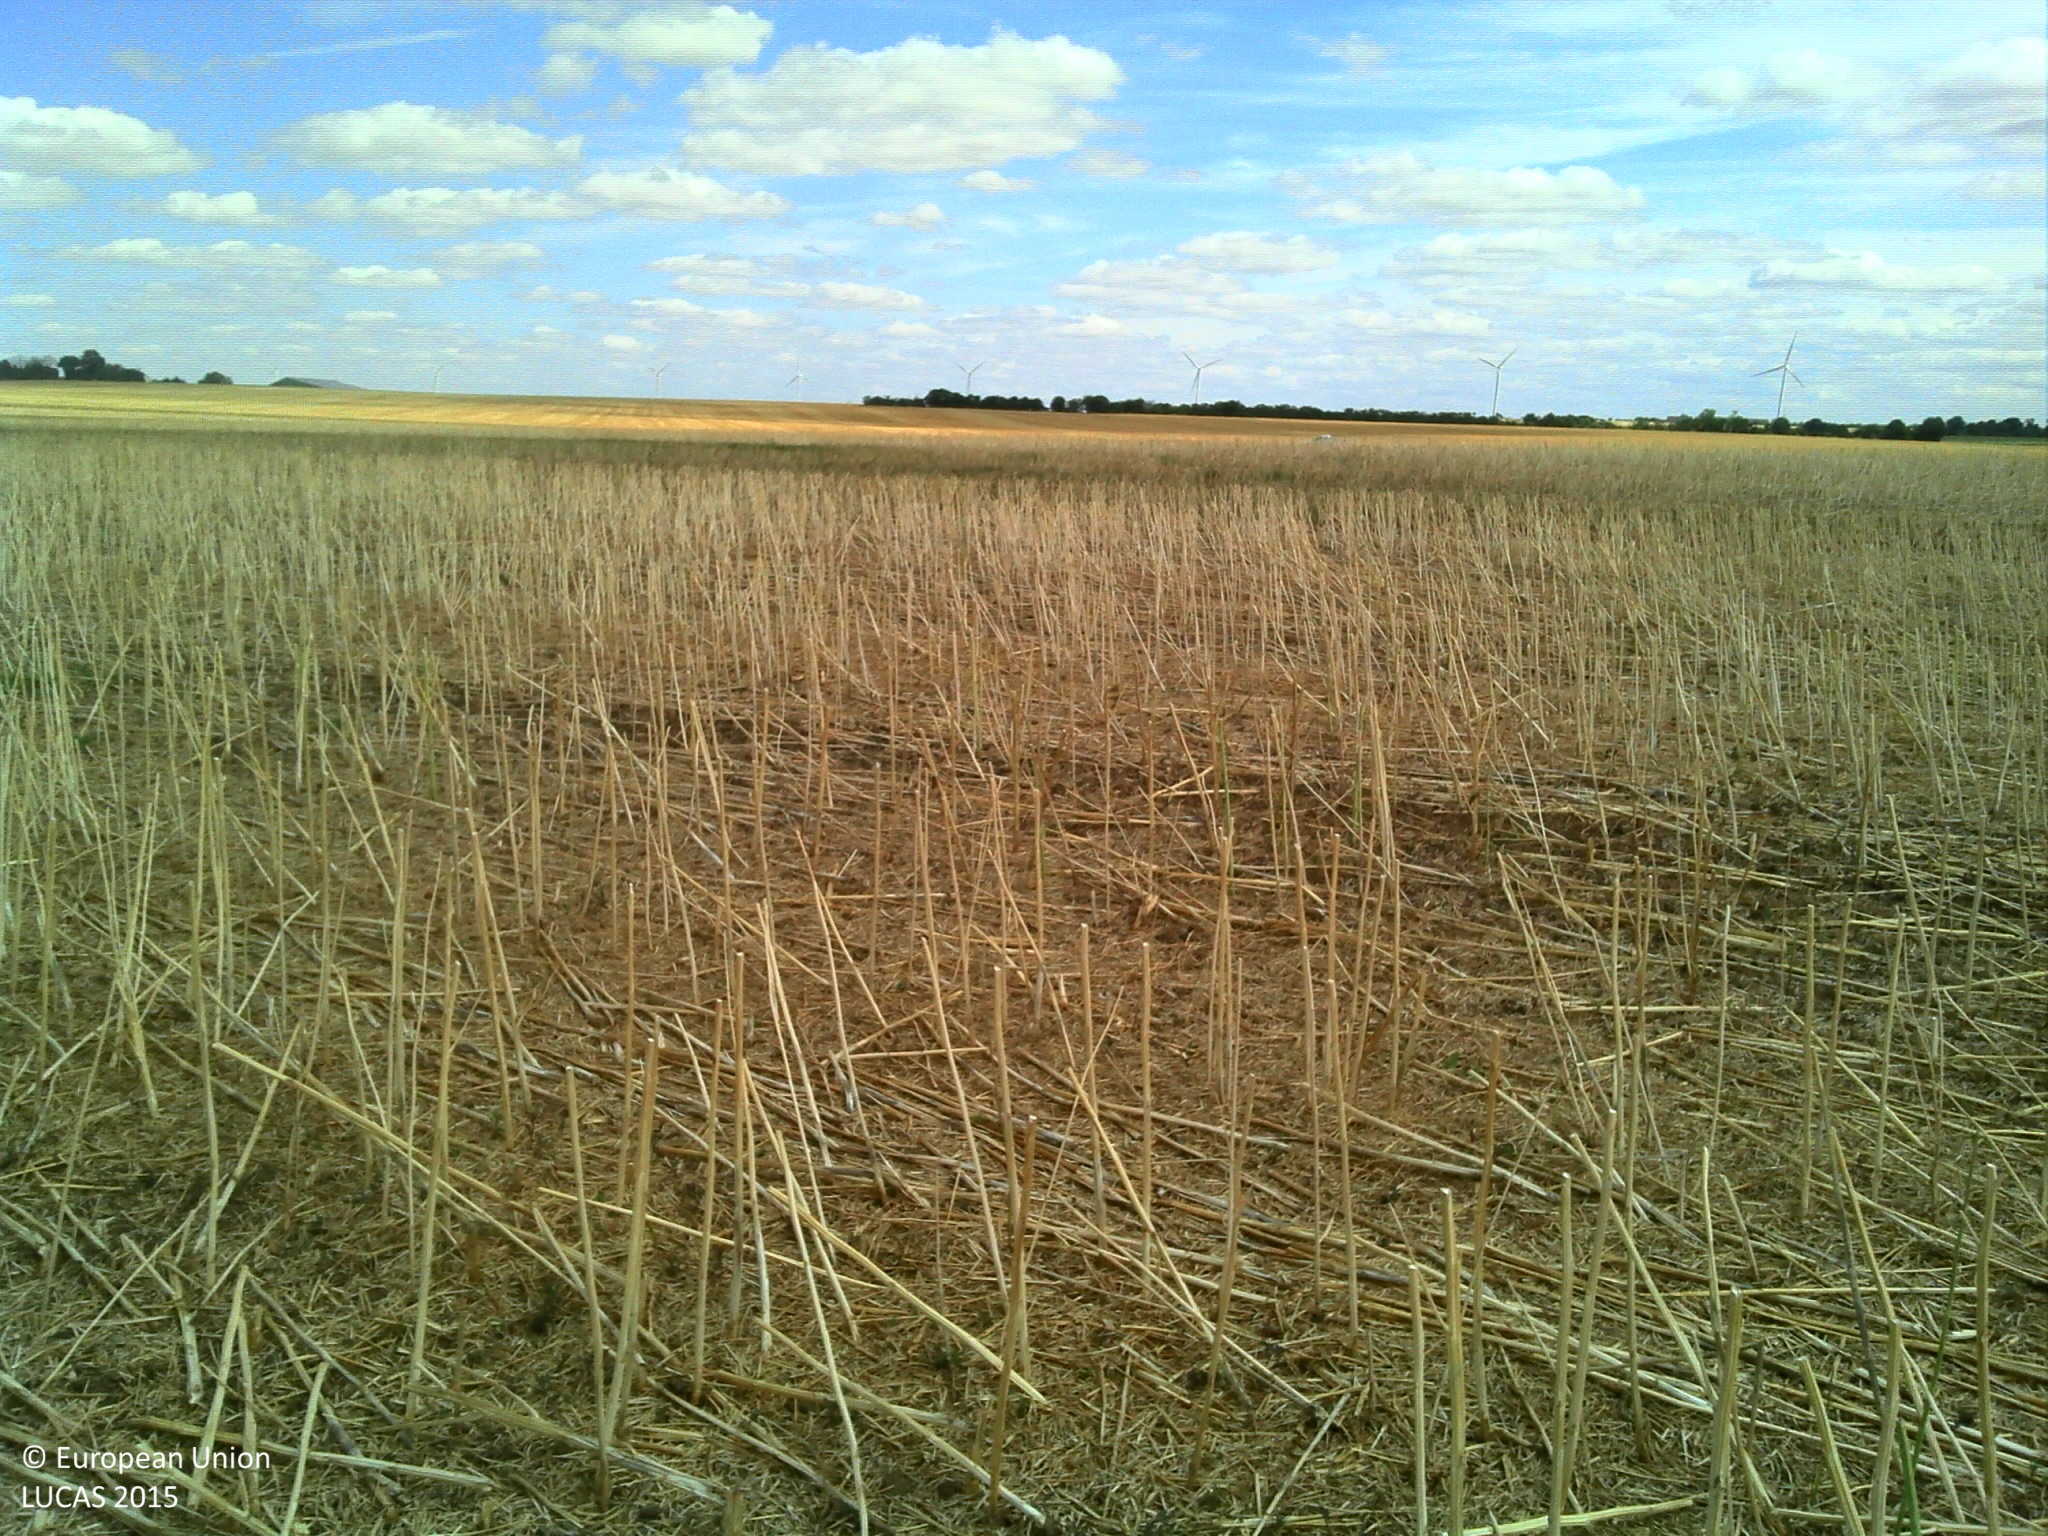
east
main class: Cropland
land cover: Rape and turnip rape
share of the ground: 25 - 50 %
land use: Agriculture (excluding fallow land and kitchen gardens)
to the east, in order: Rape and turnip rape; Tracks; Common wheat
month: July
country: FR
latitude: 46.9666
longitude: 2.1454
